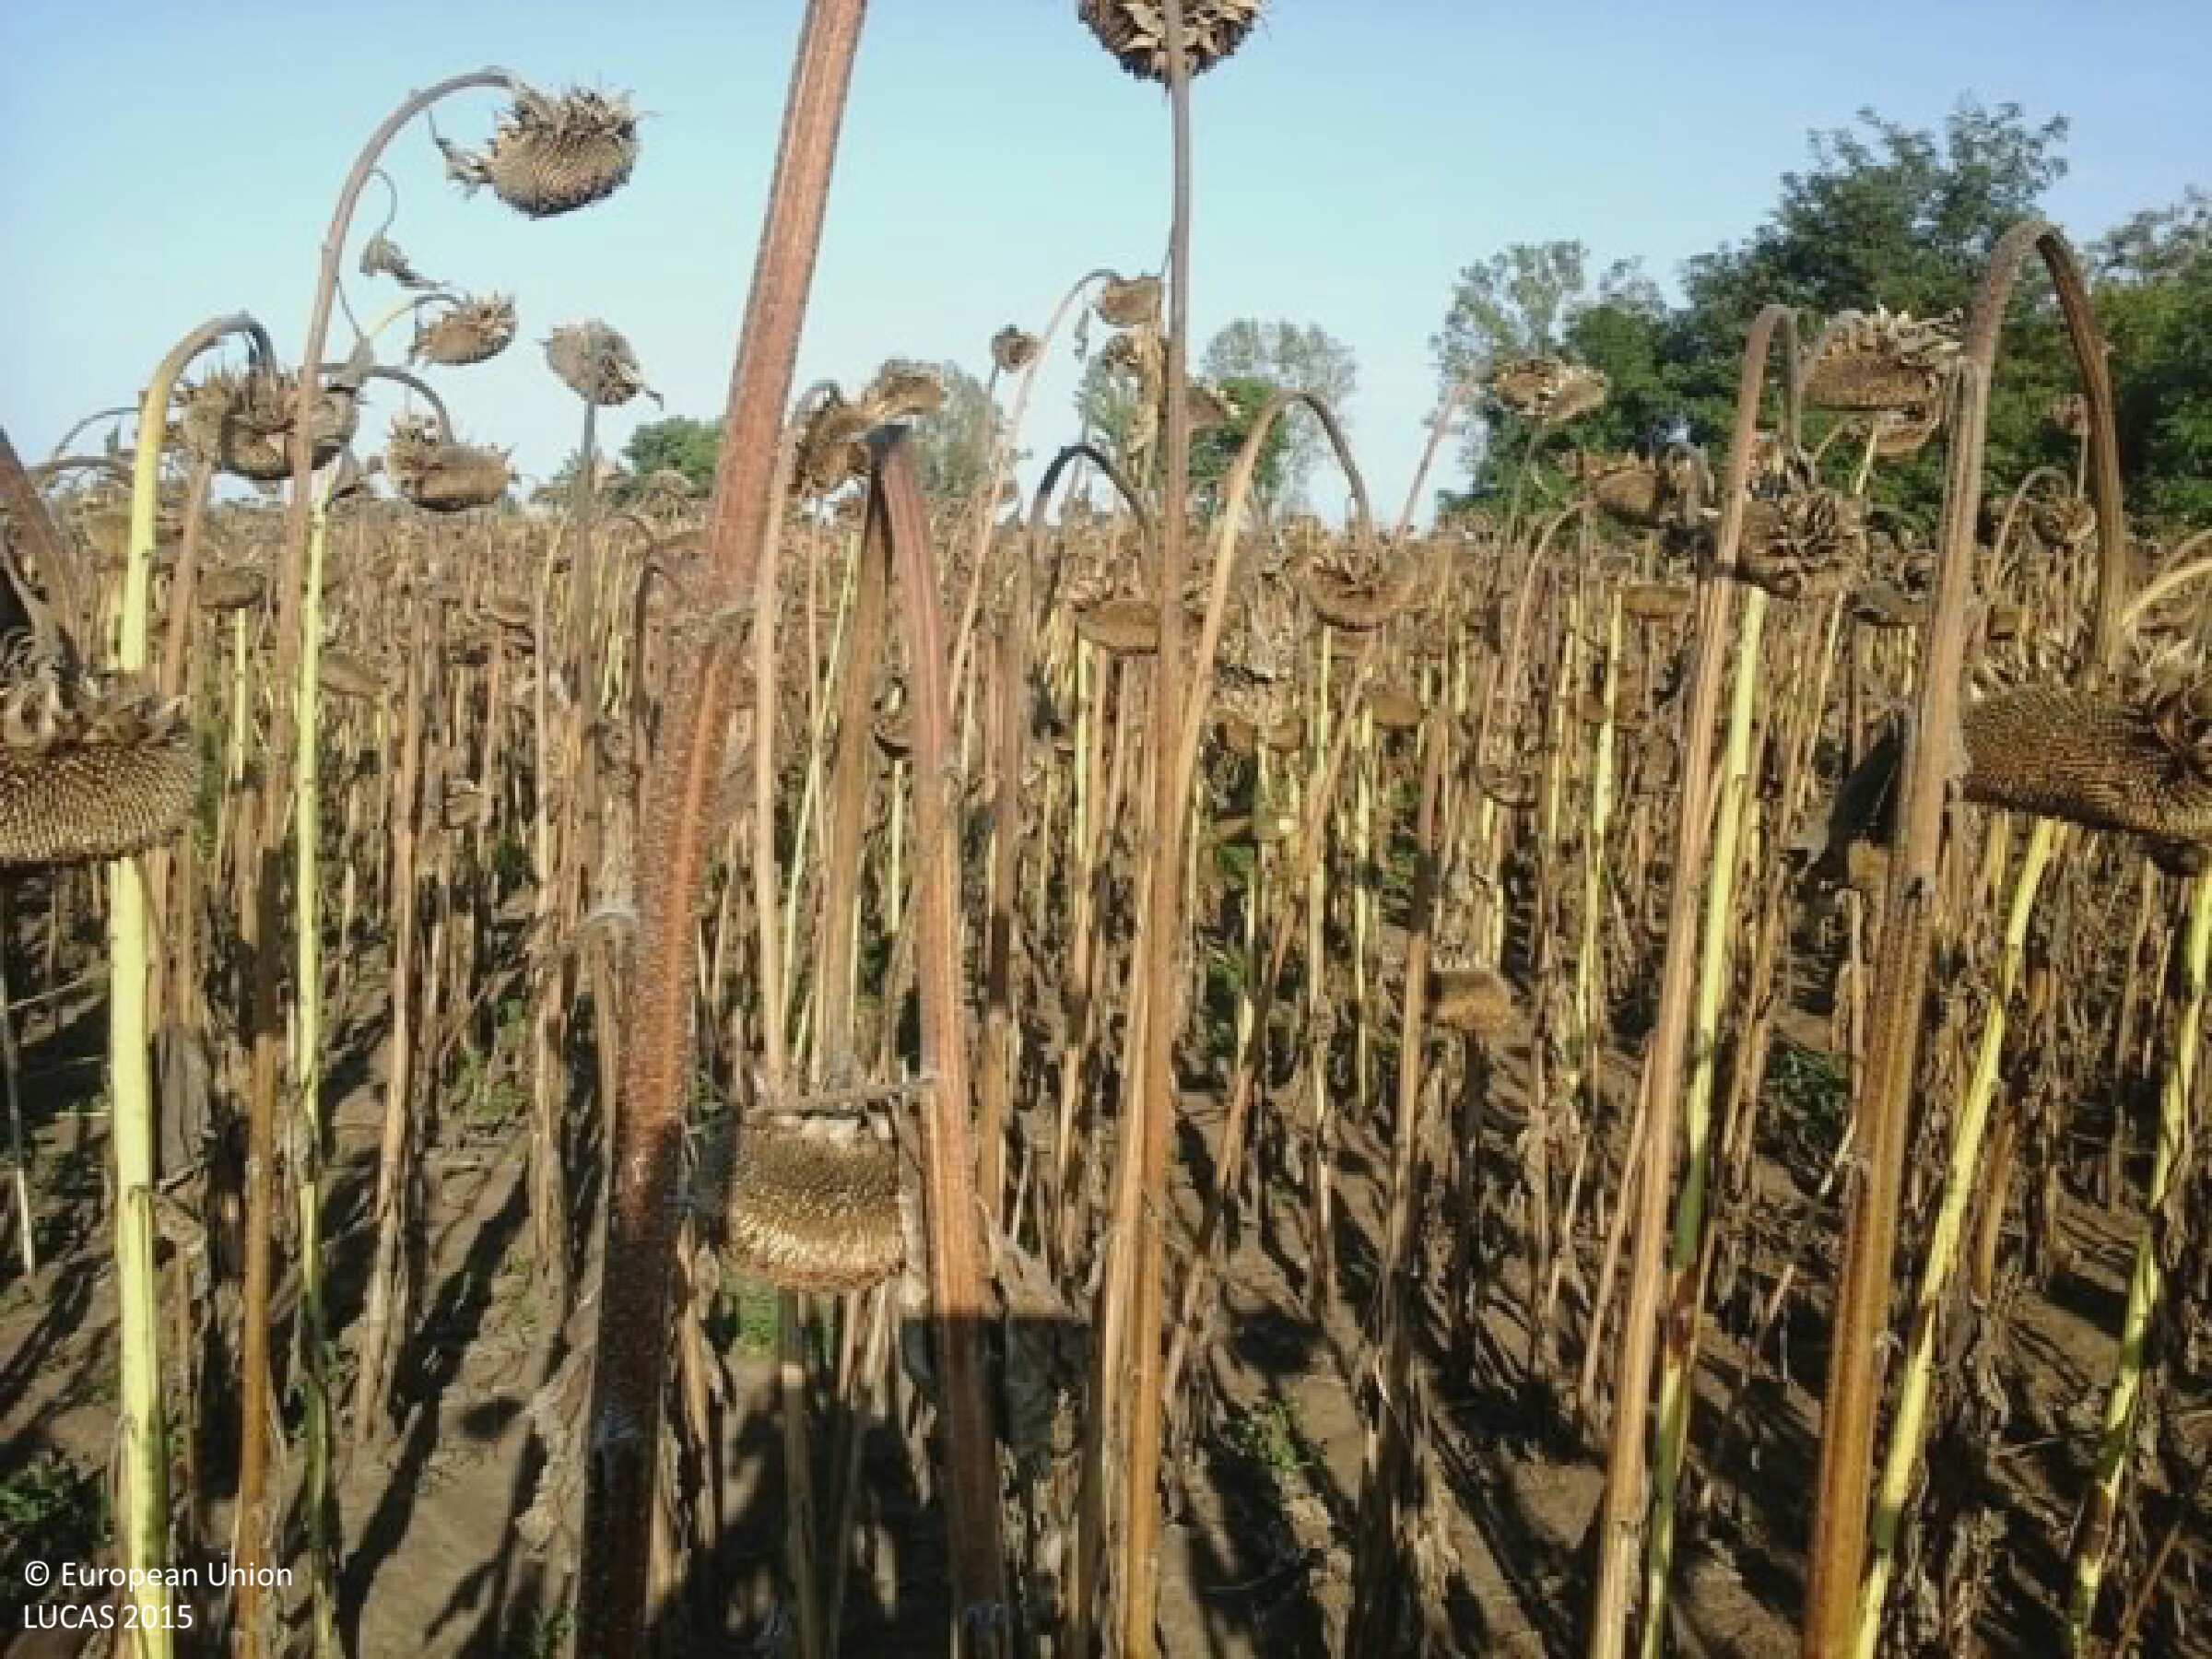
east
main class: Cropland
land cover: Sunflower
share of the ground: 50 - 75 %
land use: Agriculture (excluding fallow land and kitchen gardens)
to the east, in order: Sunflower; Broadleaved woodland; Maize; Grass margins; Ditches and canals; Grass margins; Paved roads, cycling and walking lanes; Grass margins; Ditches and canals; Grass margins; Maize
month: September
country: HU
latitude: 47.6556
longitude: 19.8378
